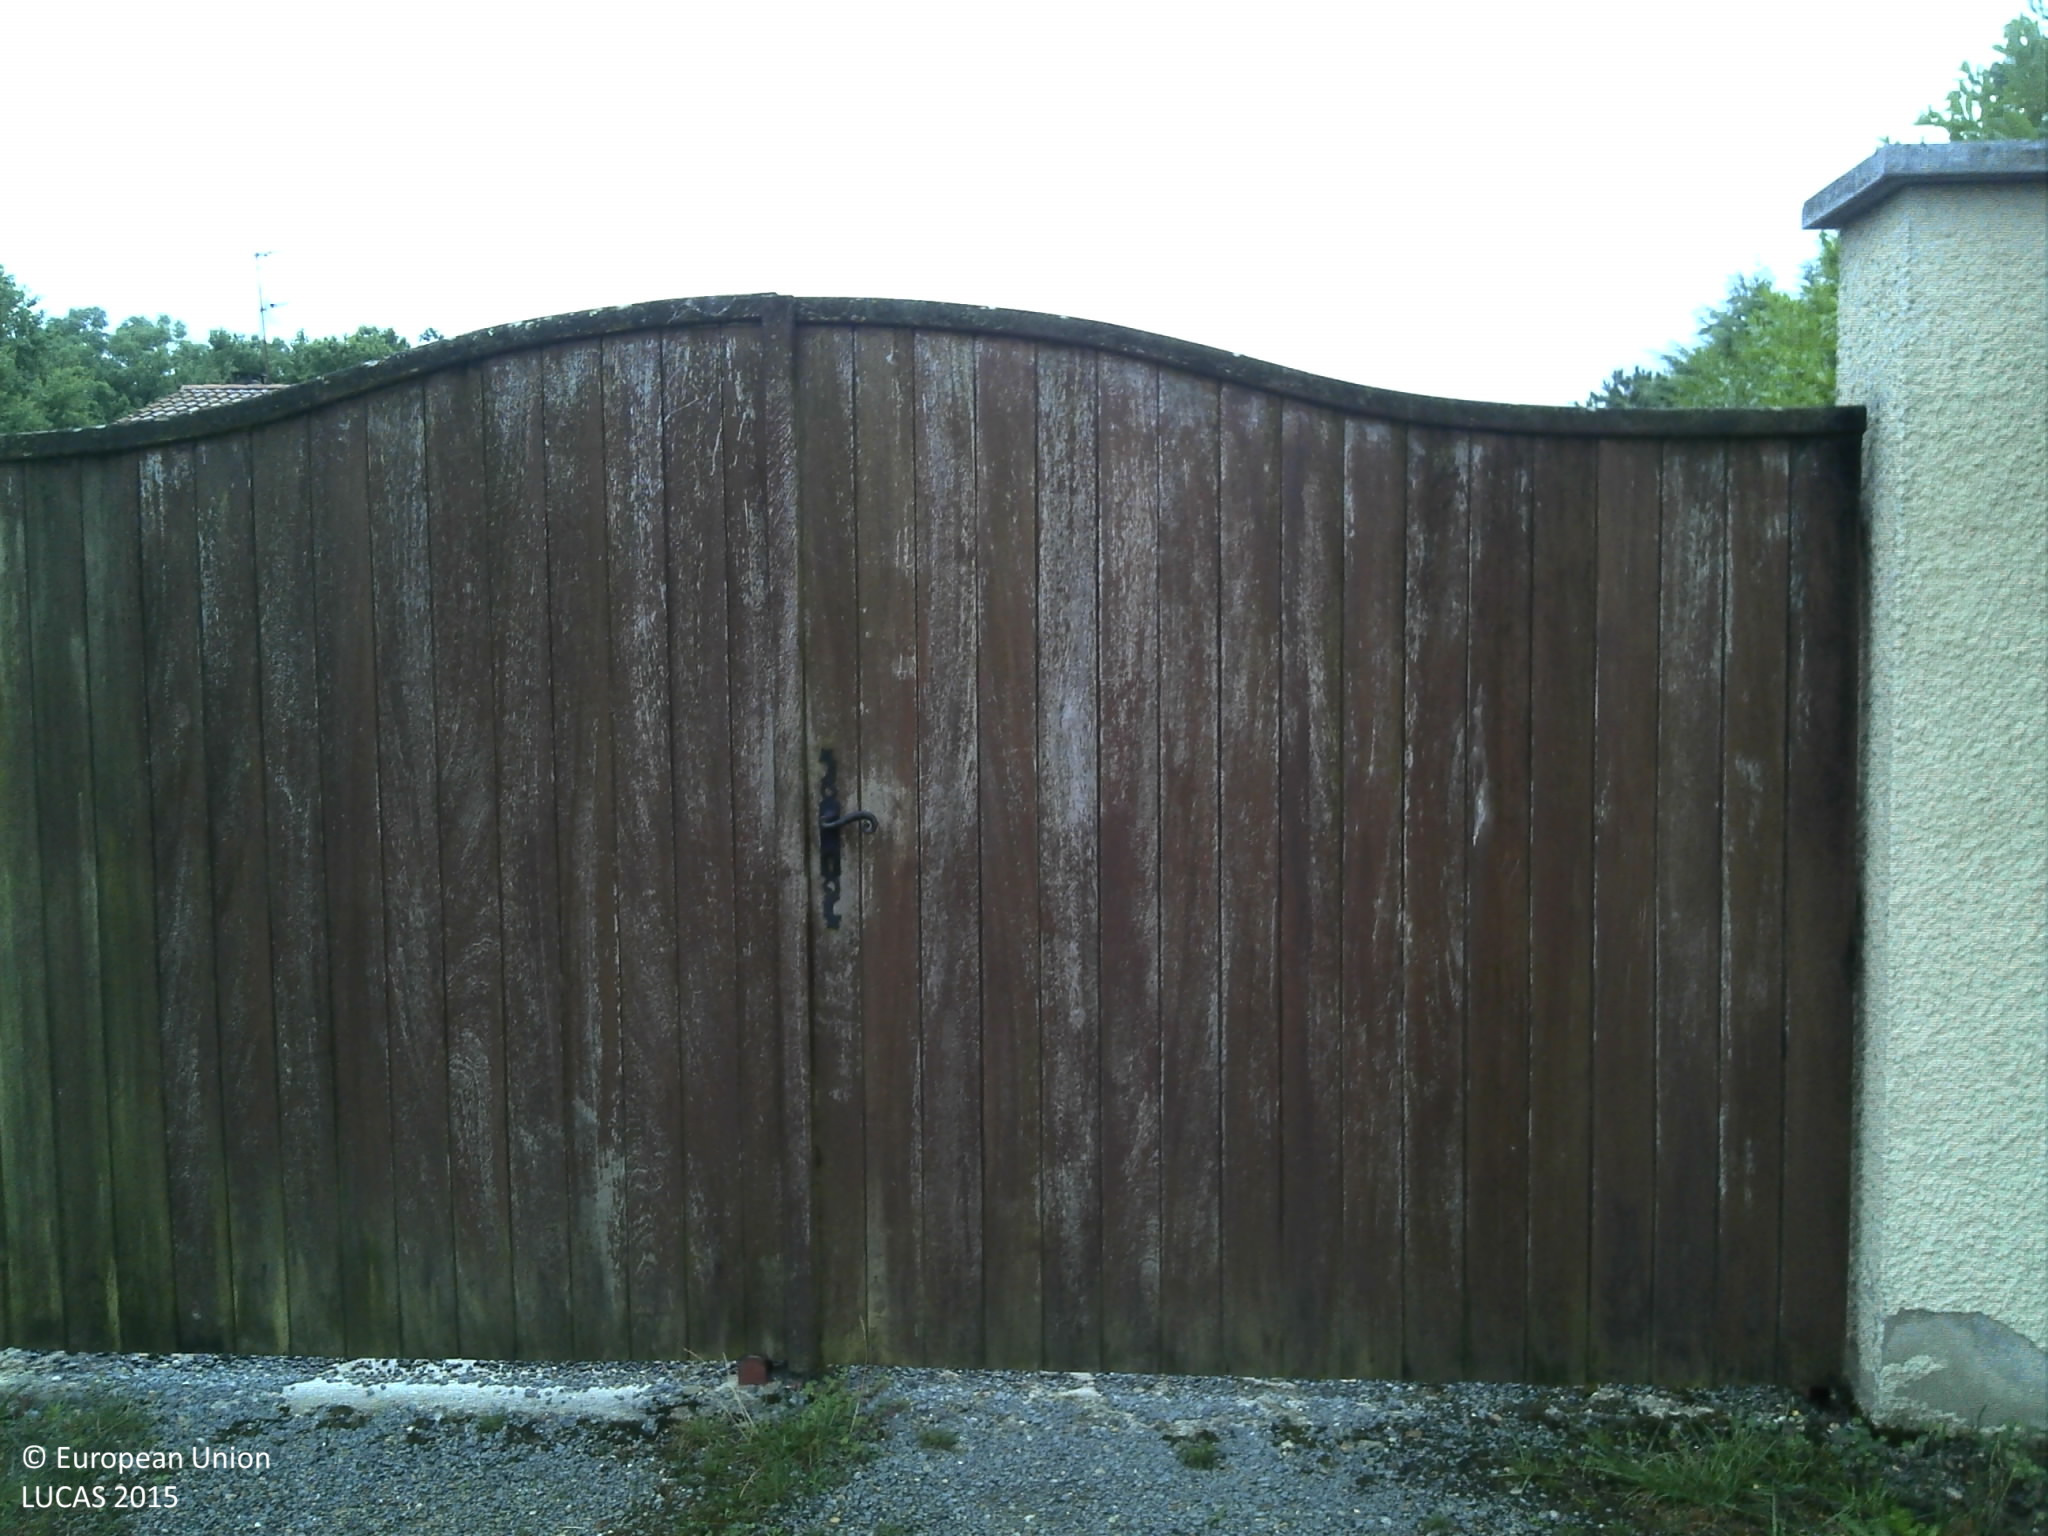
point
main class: Grassland
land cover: Grassland with sparse tree/shrub cover
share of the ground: > 75 %
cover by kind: herbaceous plants 95 %, broadleaved forest trees 5 %
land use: Residential
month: August
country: FR
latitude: 44.7342
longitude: -0.4089
